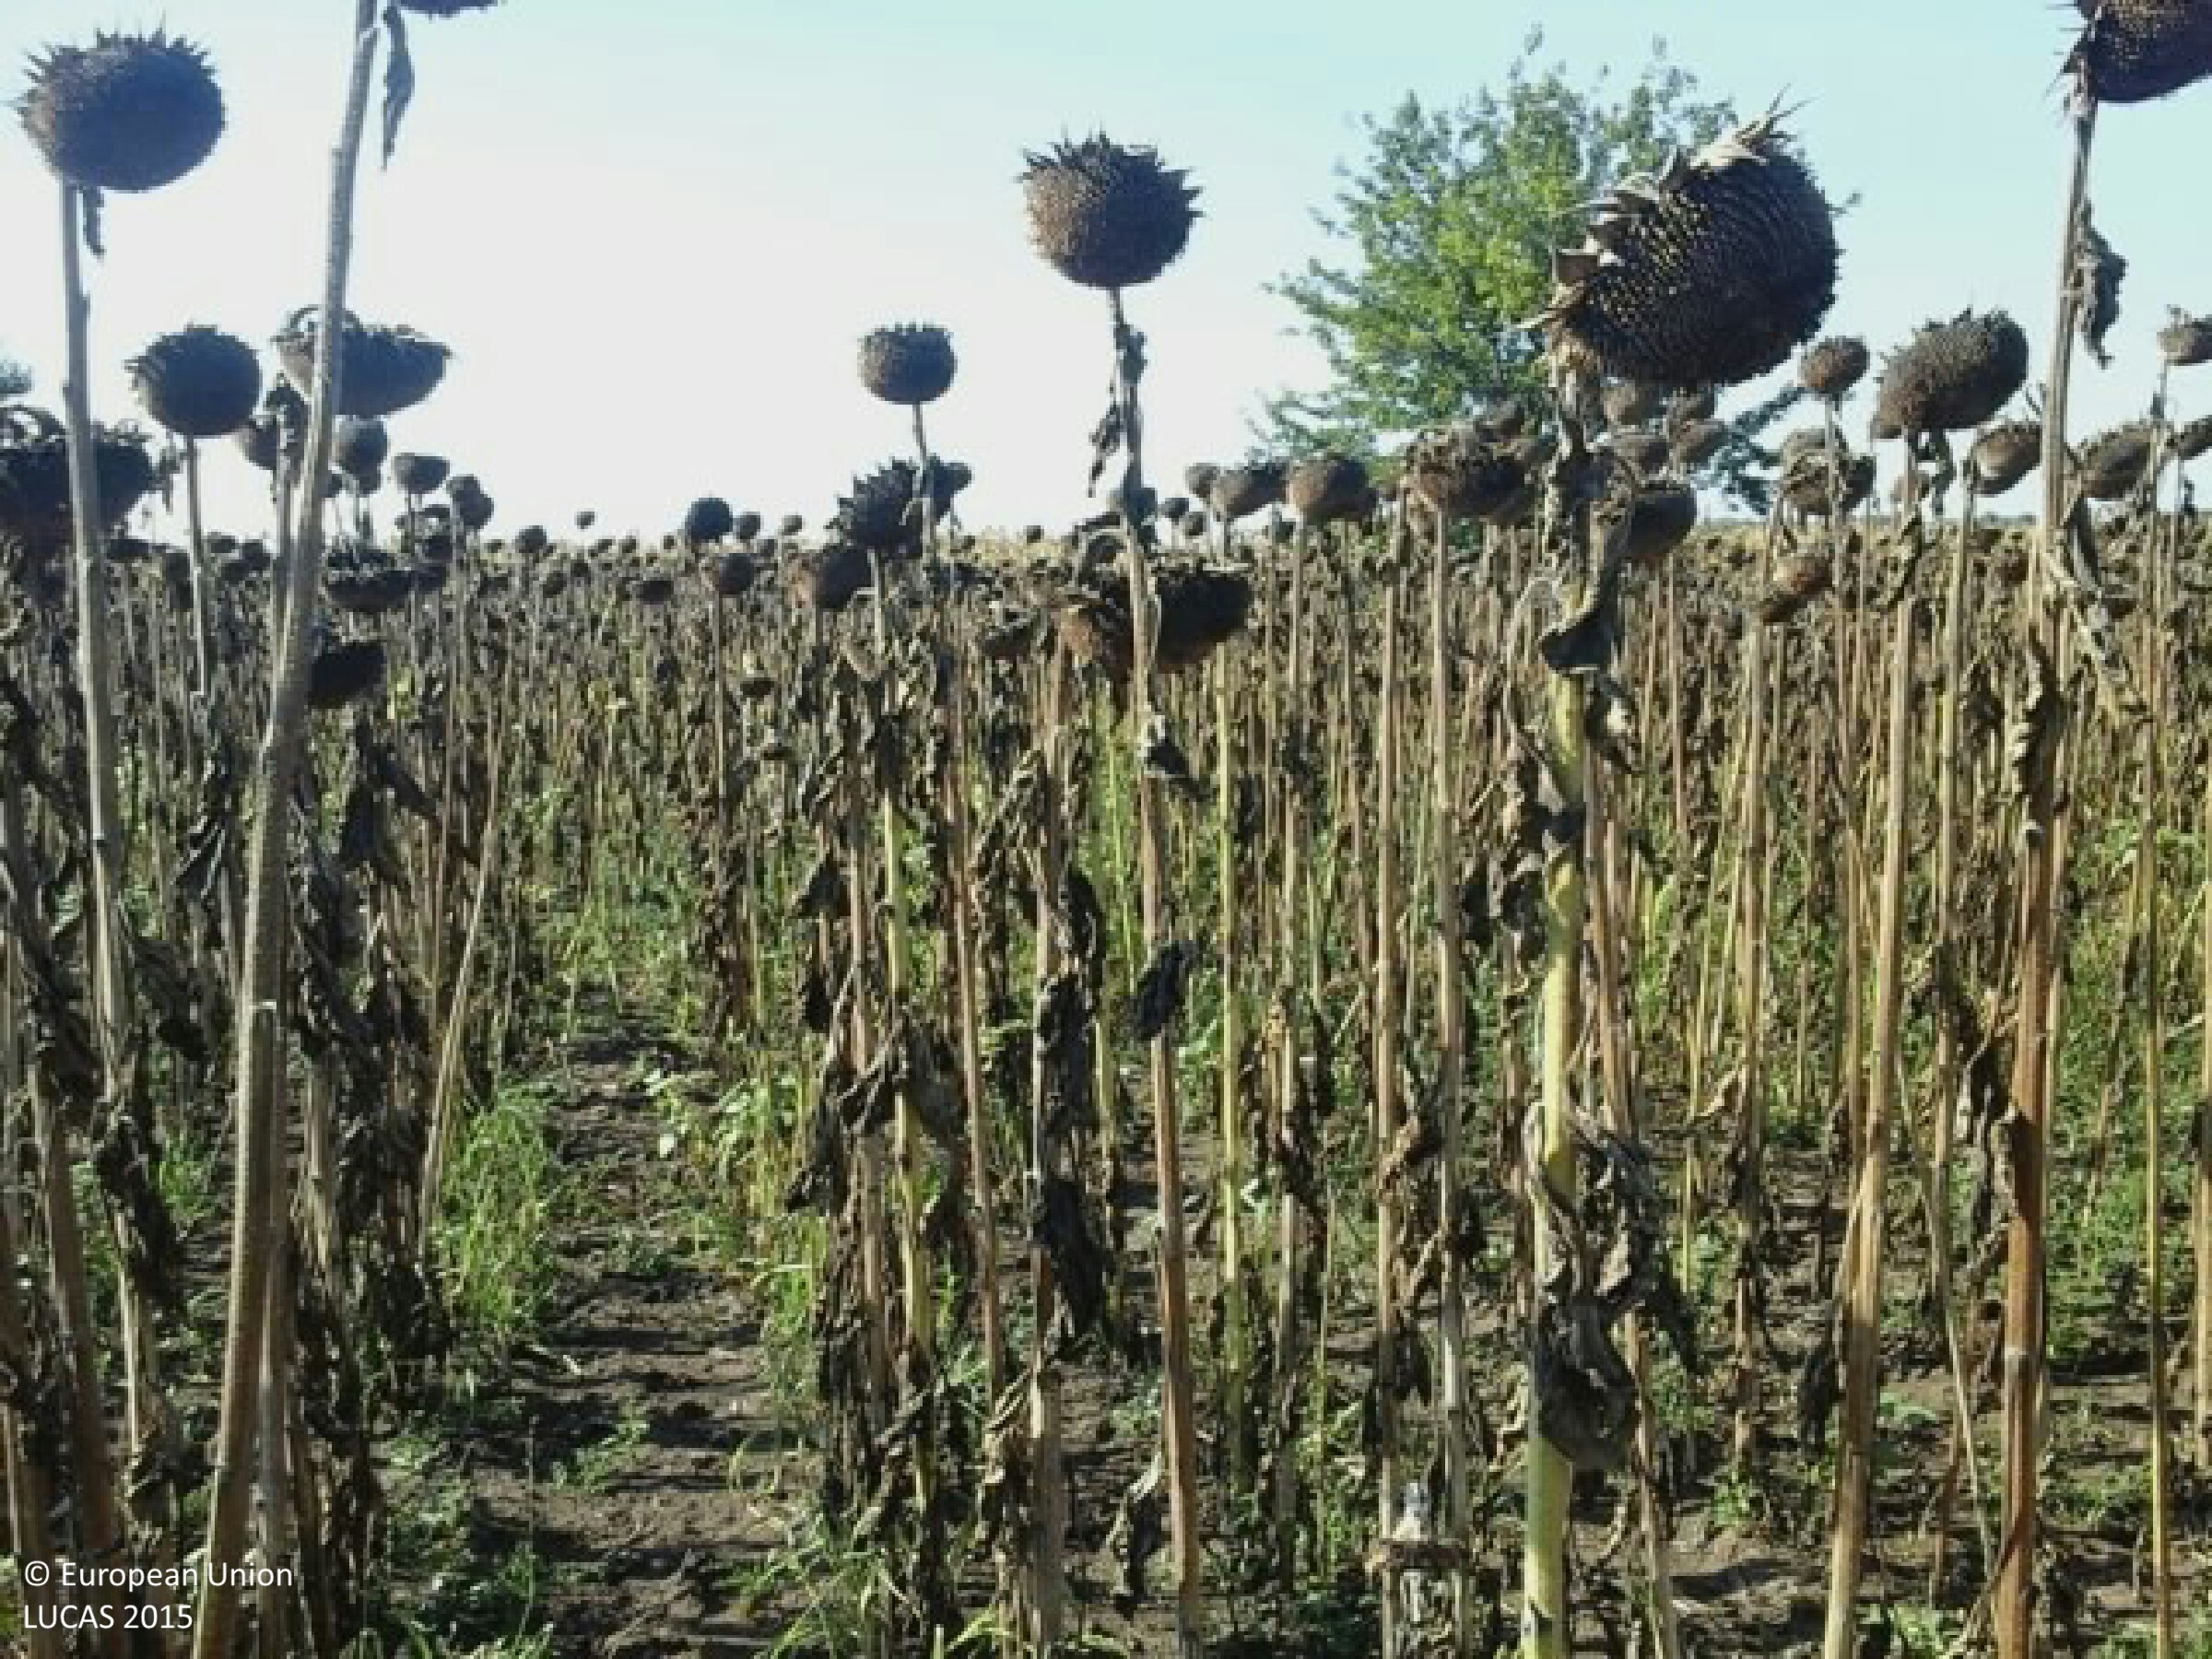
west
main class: Cropland
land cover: Sunflower
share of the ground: > 75 %
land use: Agriculture (excluding fallow land and kitchen gardens)
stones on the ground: < 10 %
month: September
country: HU
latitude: 47.6426
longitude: 19.7816
